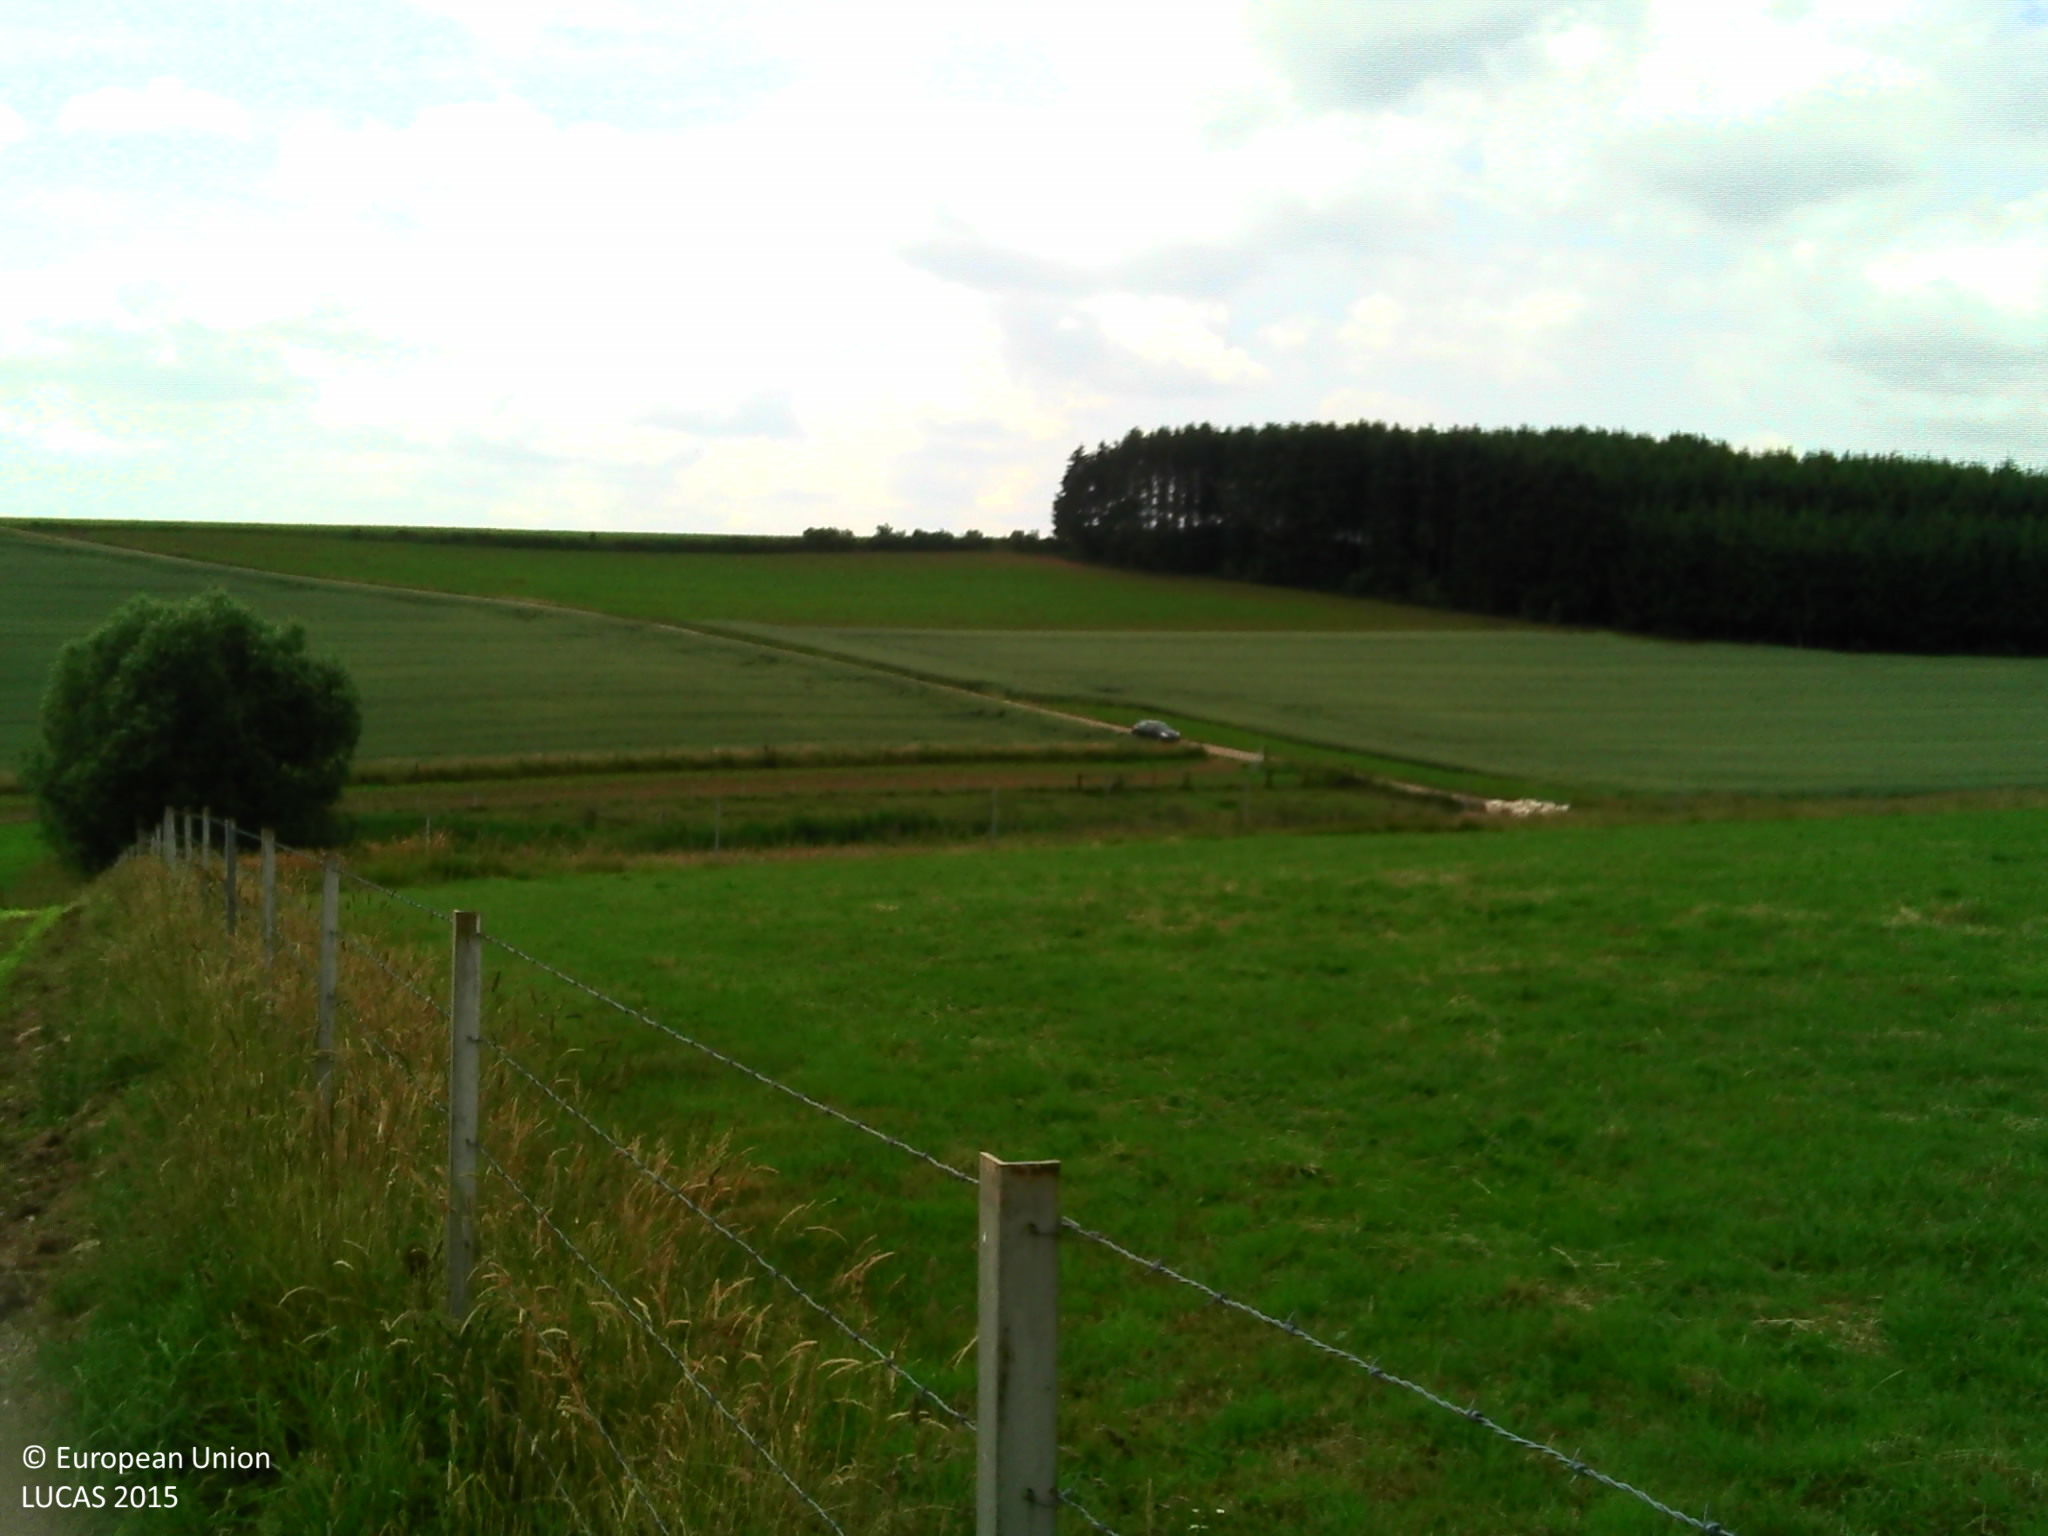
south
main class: Grassland
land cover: Grassland without tree/shrub cover
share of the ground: > 75 %
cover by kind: herbaceous plants 100 %
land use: Agriculture (excluding fallow land and kitchen gardens)
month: June
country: LU
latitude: 49.8443
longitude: 6.0081
